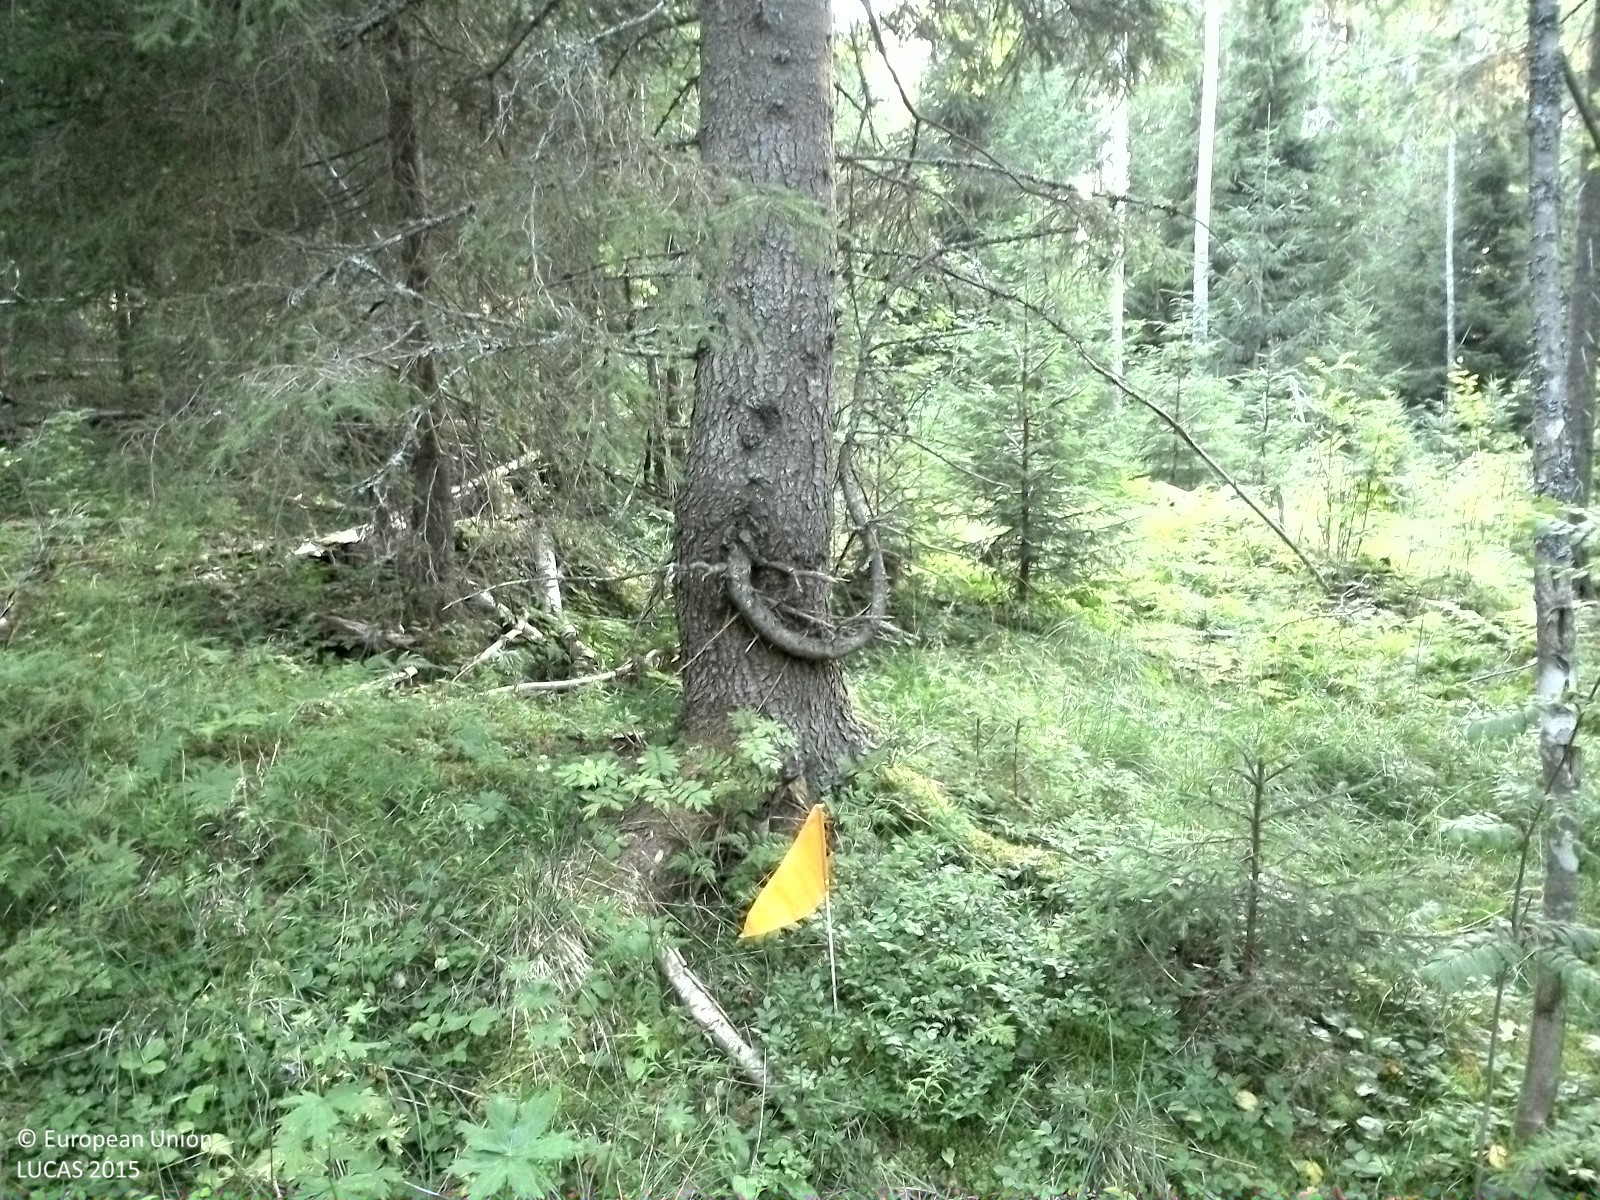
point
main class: Woodland
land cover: Spruce dominated mixed woodland
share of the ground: 25 - 50 %
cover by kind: herbaceous plants 50 %, coniferous forest trees 35 %, broadleaved forest trees 15 %
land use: Forestry
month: August
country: SE
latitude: 62.3108
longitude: 16.8671
